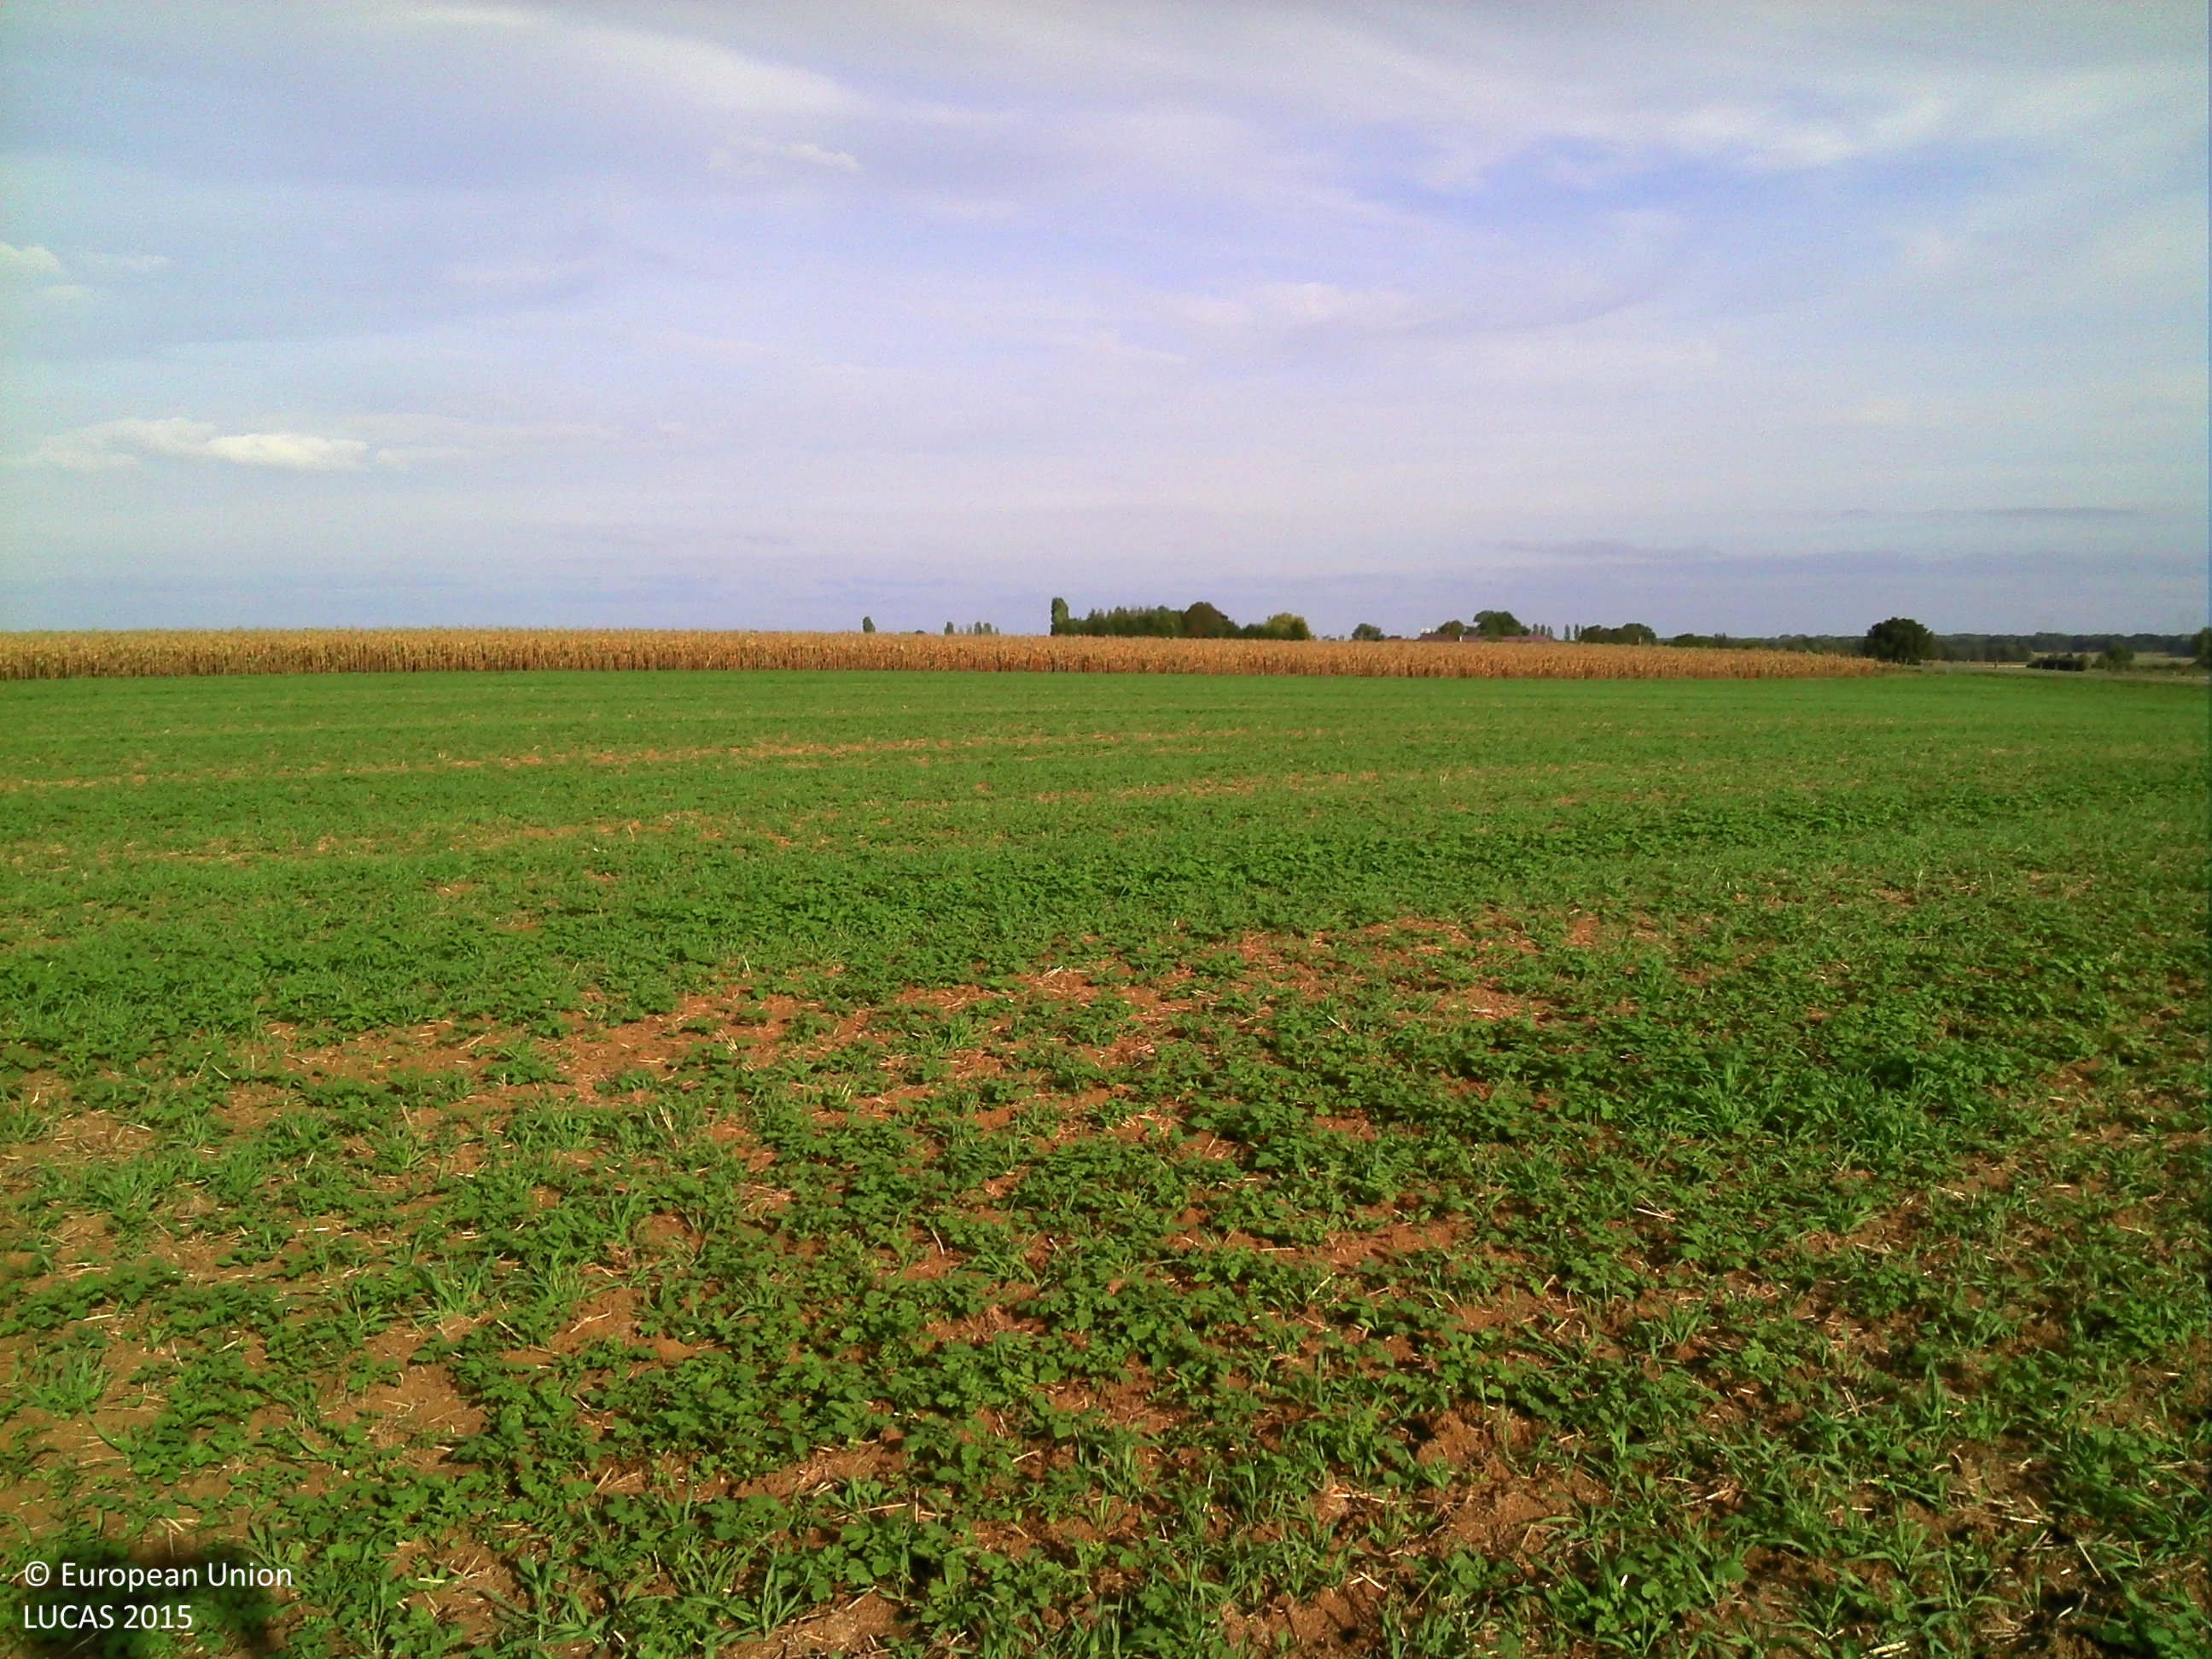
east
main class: Cropland
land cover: Other fibre and oleaginous crops
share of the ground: > 75 %
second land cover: Other leguminous and mixtures for fodder
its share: < 10 %
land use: Agriculture (excluding fallow land and kitchen gardens)
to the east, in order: Other fibre and oleaginous crops; Other leguminous and mixtures for fodder; Maize
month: September
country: FR
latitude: 48.5238
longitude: 4.5950
